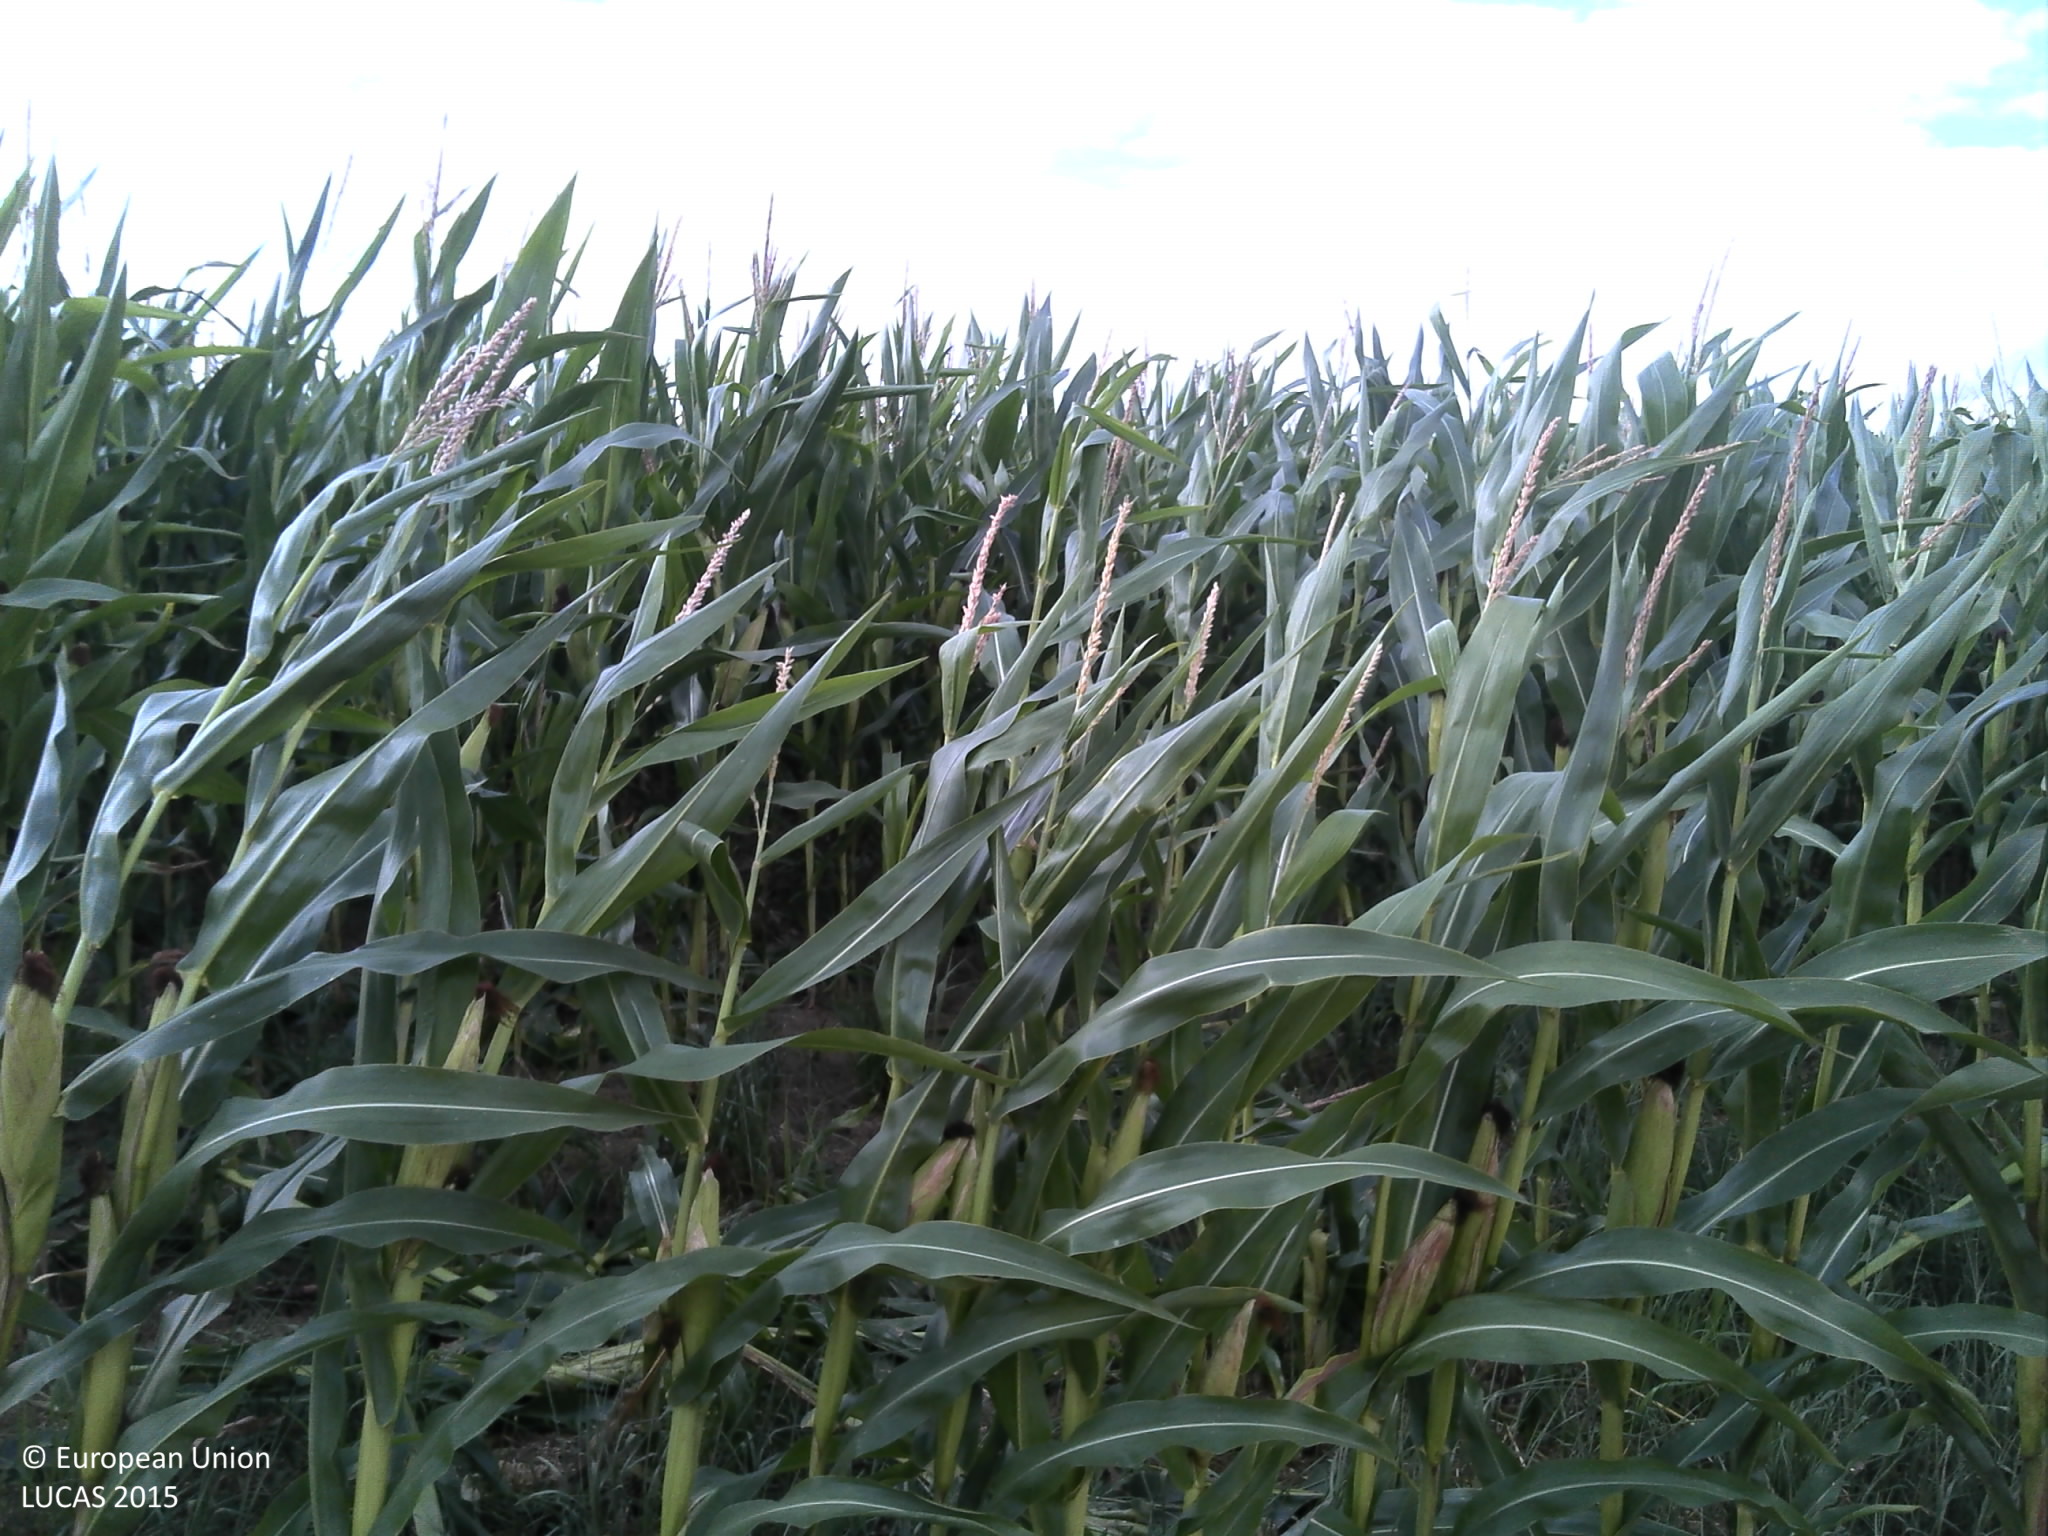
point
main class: Cropland
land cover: Maize
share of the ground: > 75 %
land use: Agriculture (excluding fallow land and kitchen gardens)
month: July
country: FR
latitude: 49.4755
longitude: 4.5173
